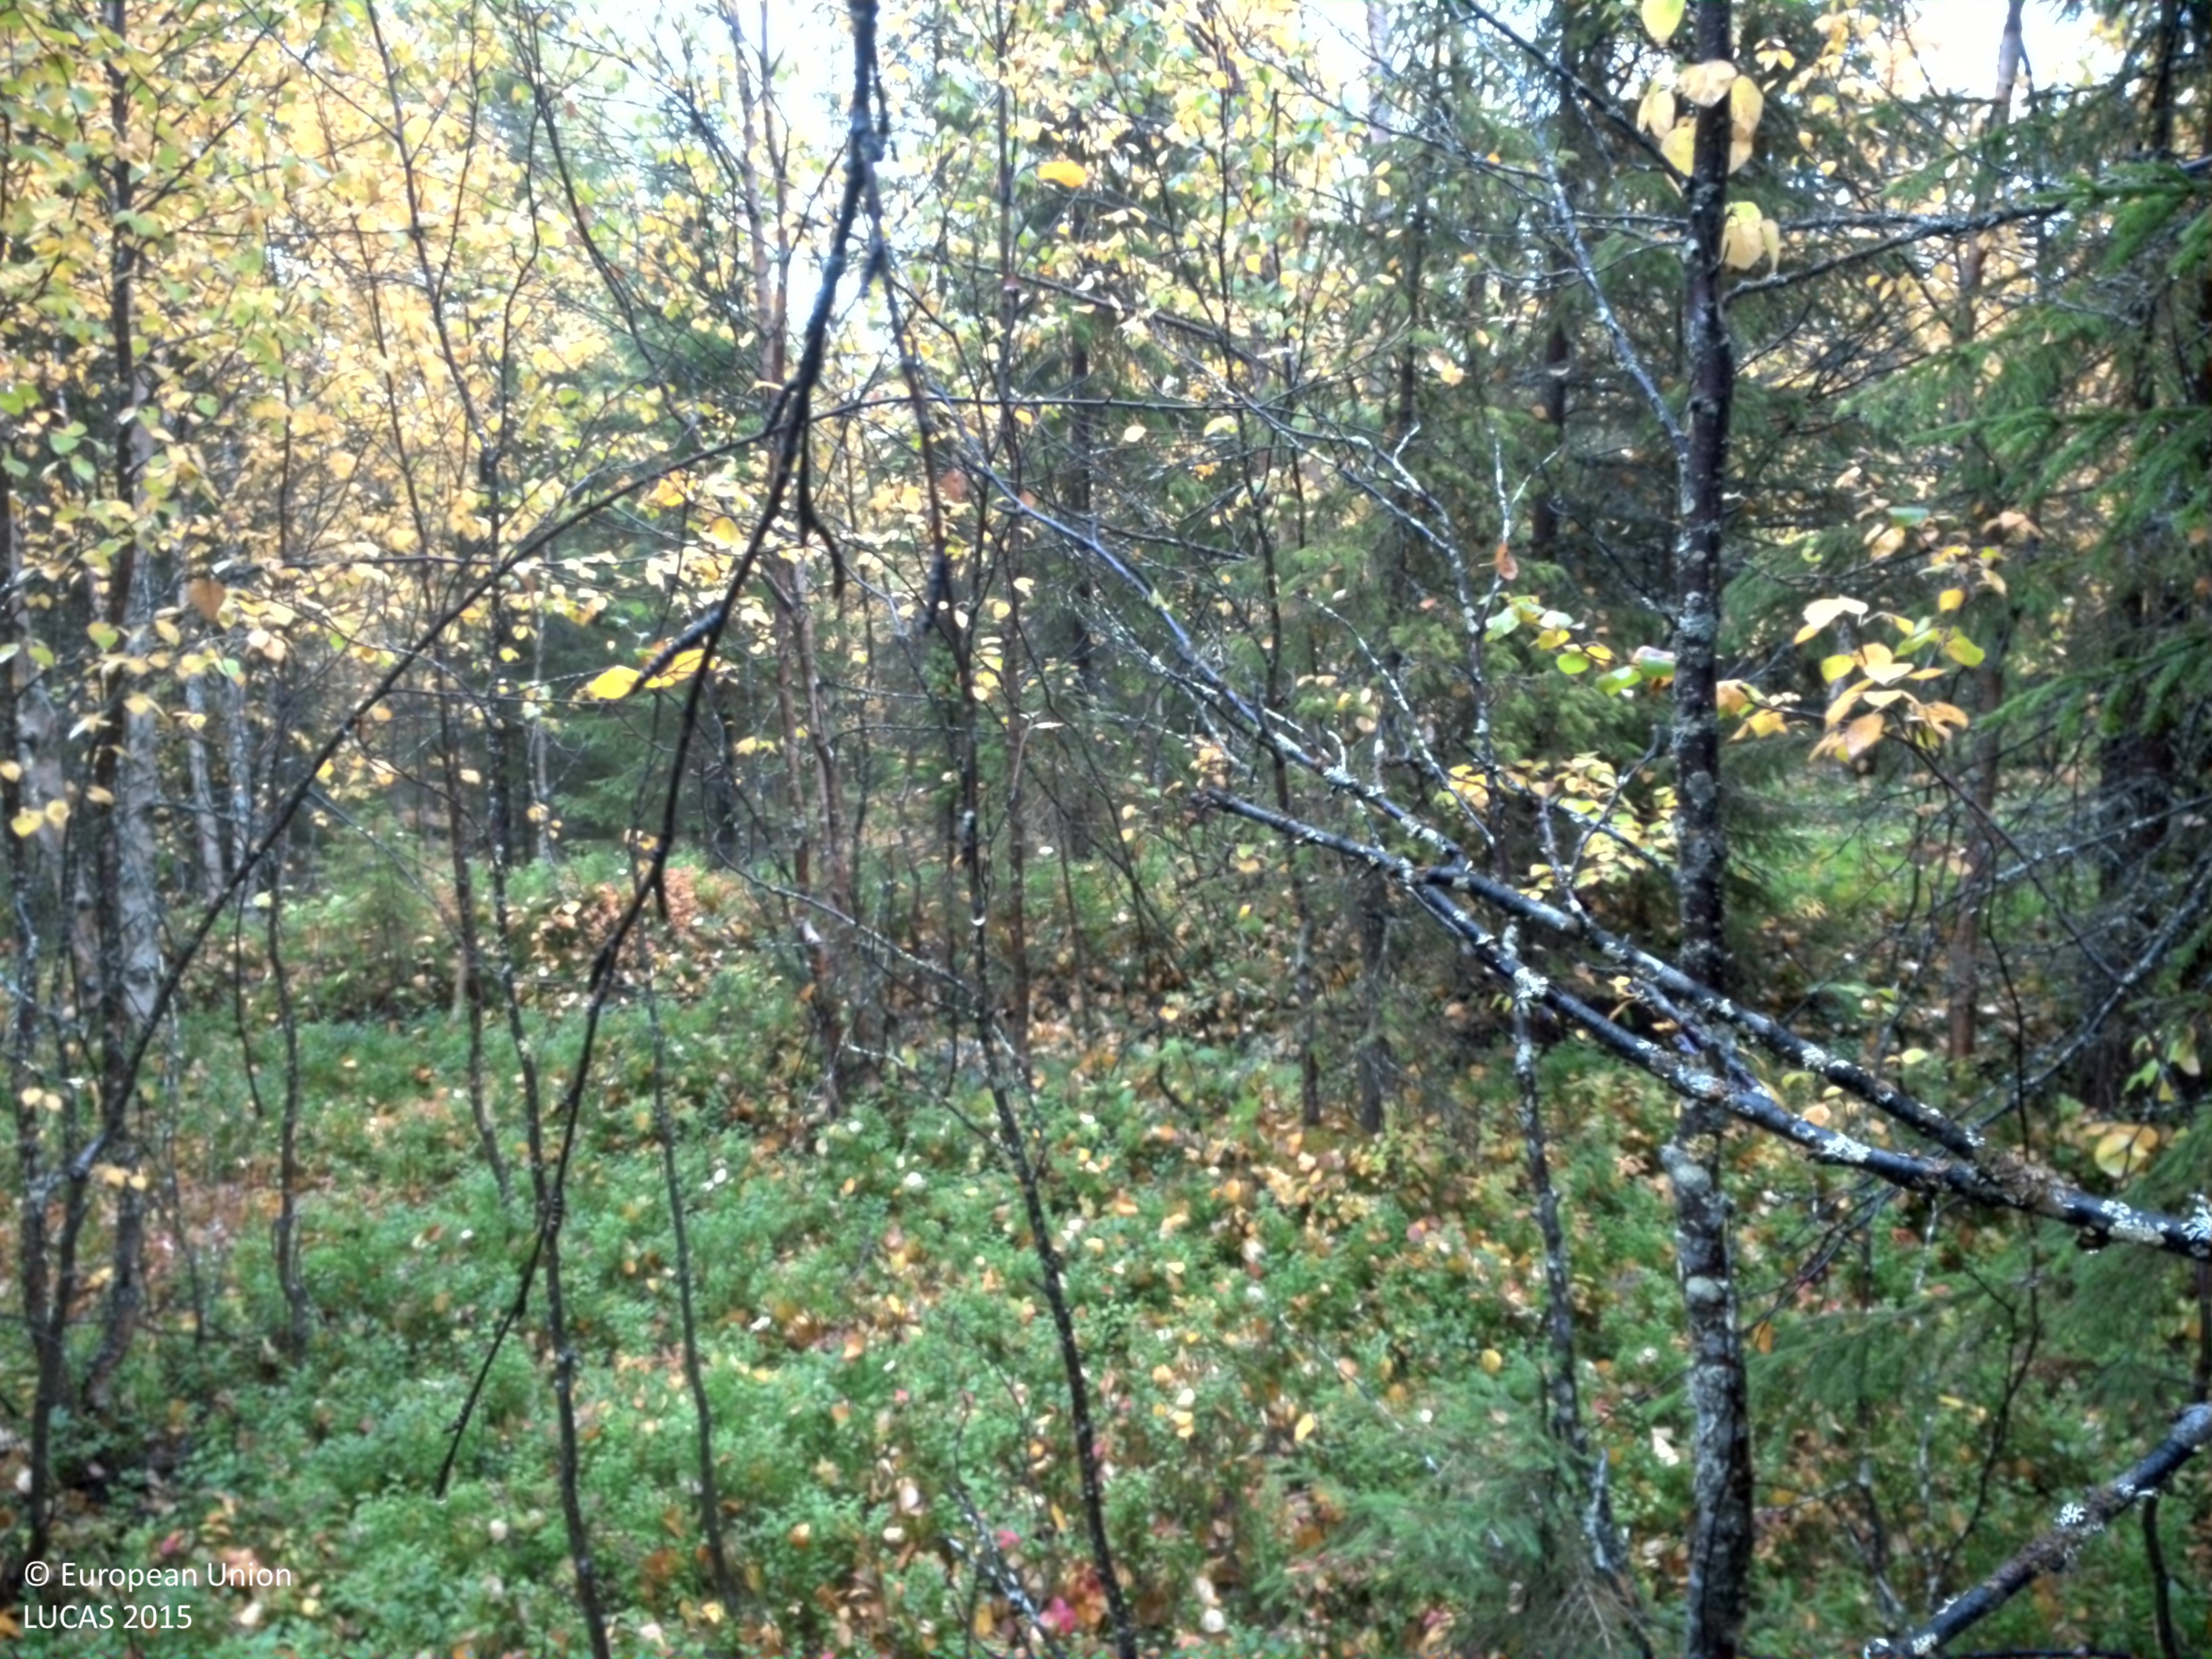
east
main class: Woodland
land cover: Spruce dominated mixed woodland
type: boreal forest
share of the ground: 50 - 75 %
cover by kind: coniferous forest trees 40 %, shrubs 25 %, broadleaved forest trees 20 %, herbaceous plants 10 %, lichens and mosses 5 %
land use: Forestry
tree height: > 5 m
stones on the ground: < 10 %
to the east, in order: Spruce dominated mixed woodland; Grassland with sparse tree/shrub cover
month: September
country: SE
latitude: 65.2332
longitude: 16.3174
